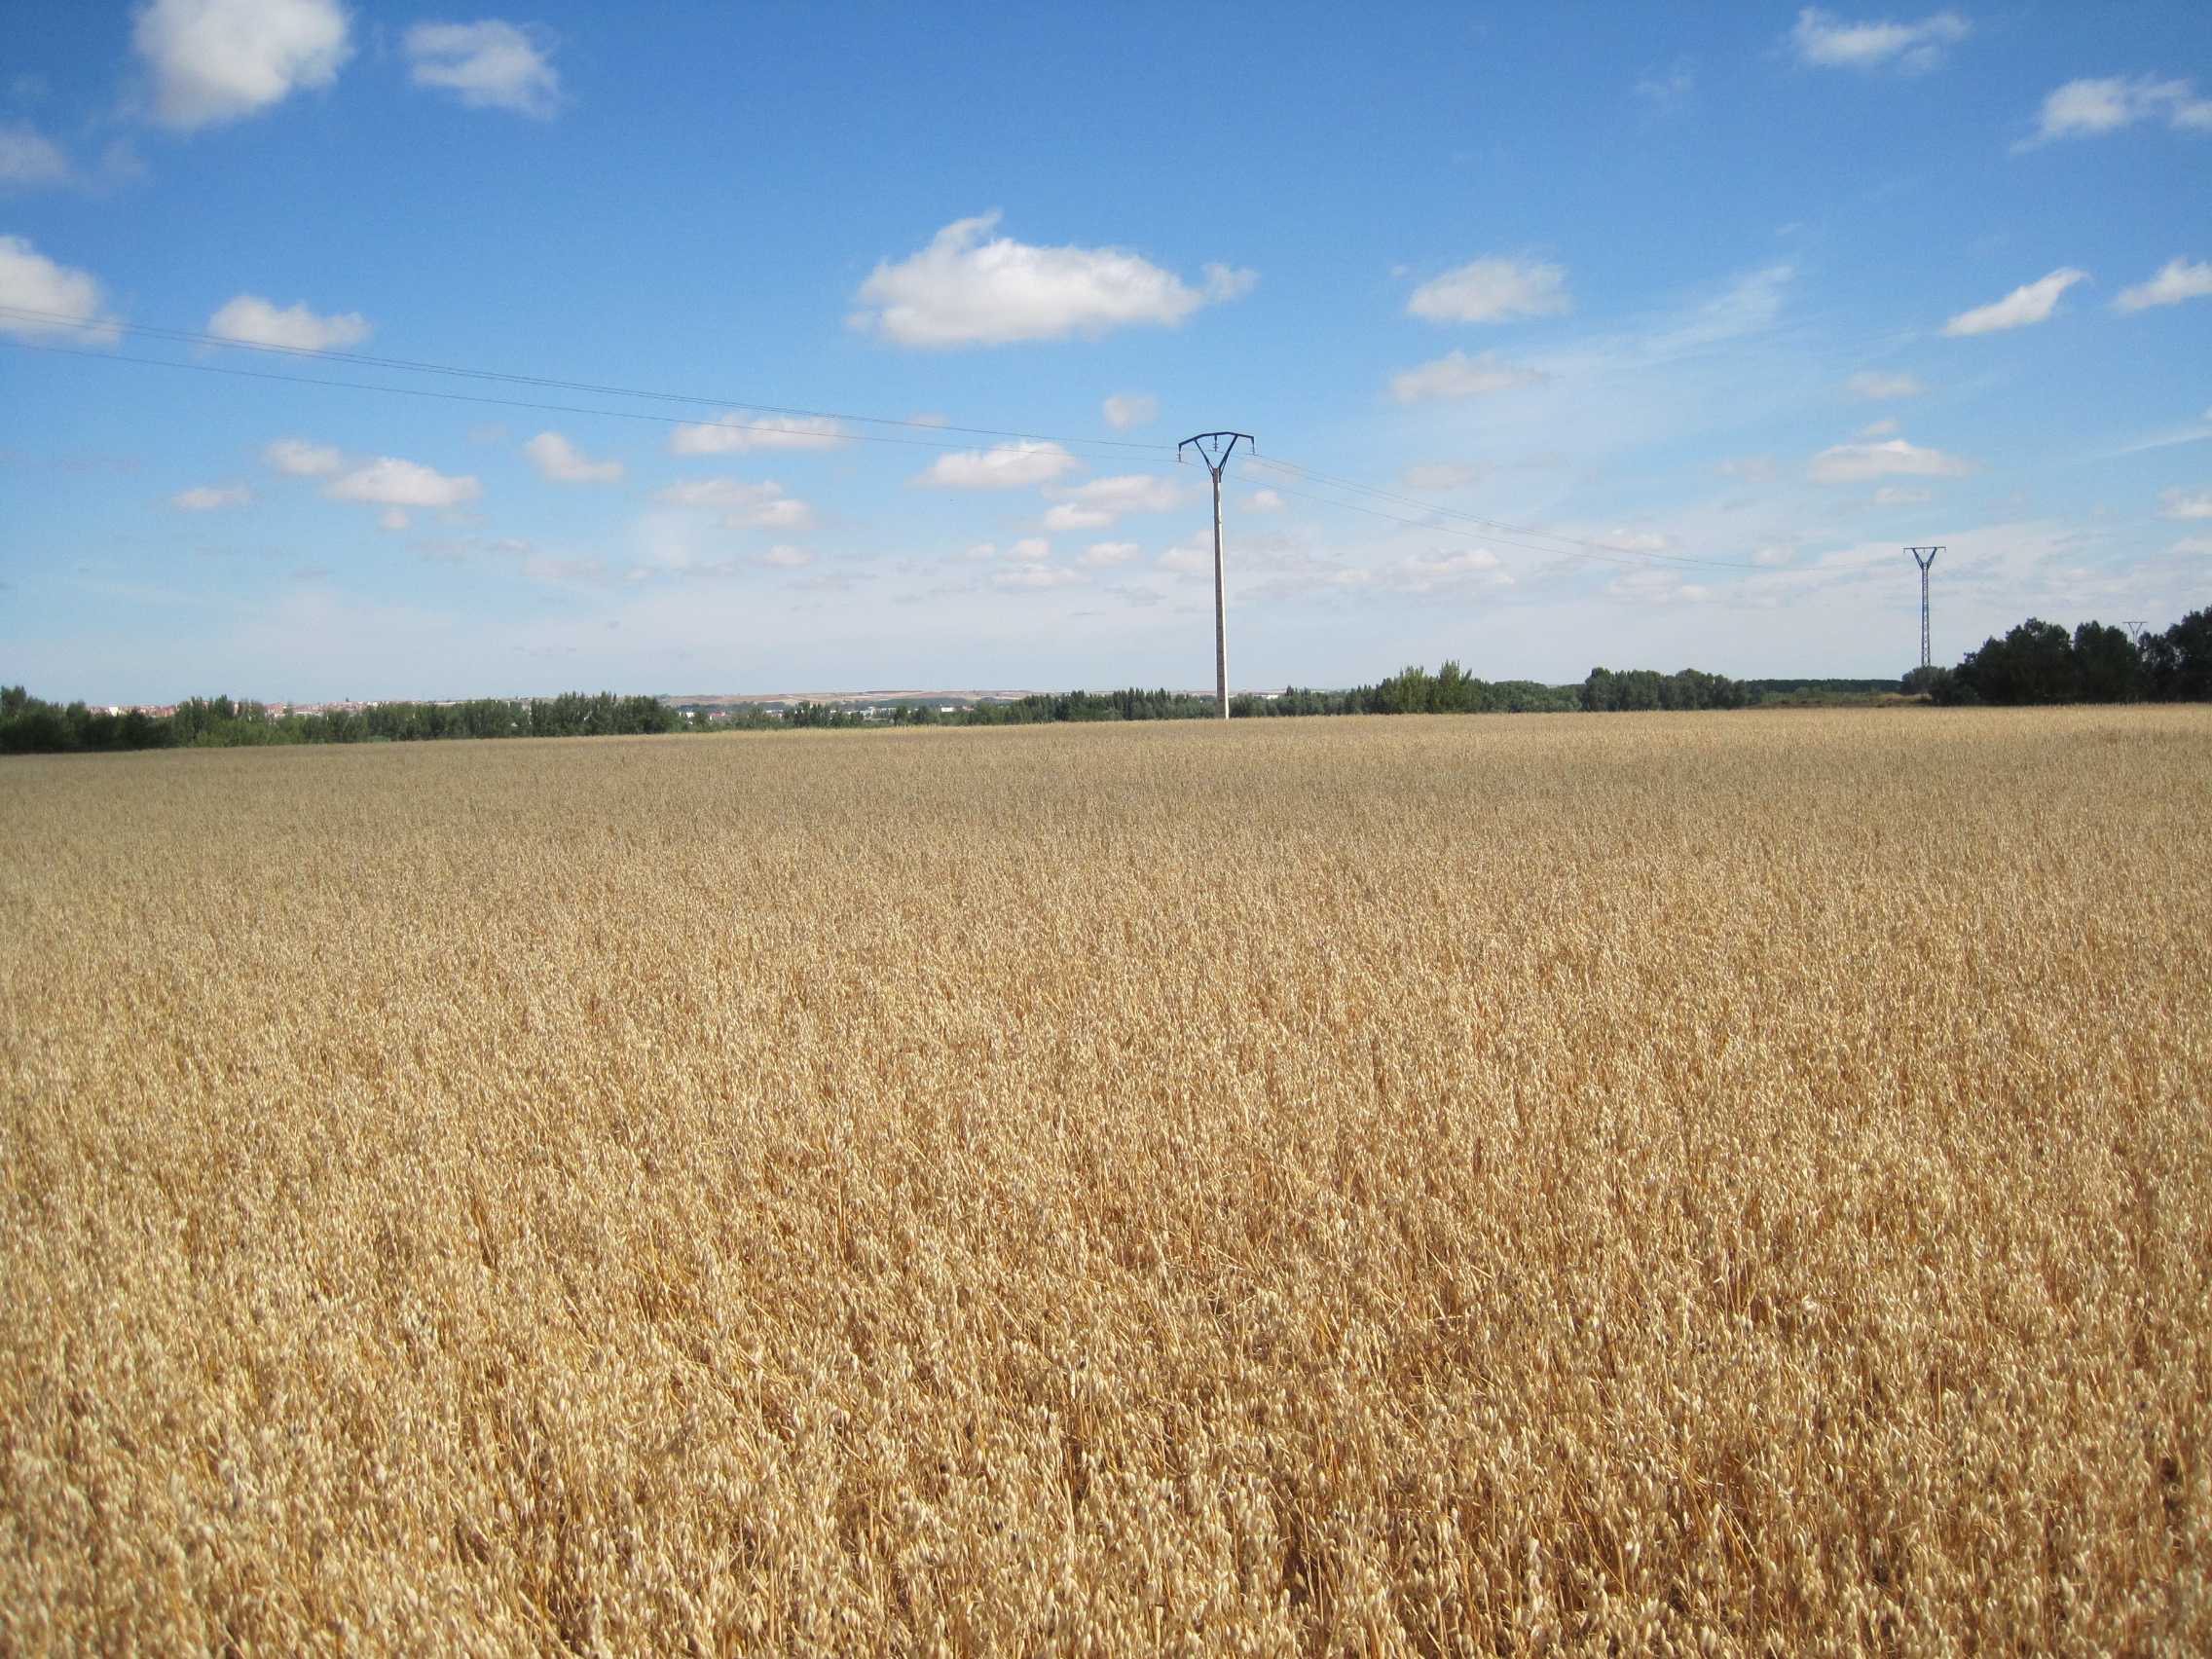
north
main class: Cropland
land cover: Oats
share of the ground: > 75 %
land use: Agriculture (excluding fallow land and kitchen gardens)
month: July
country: ES
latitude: 41.9623
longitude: -5.6432
